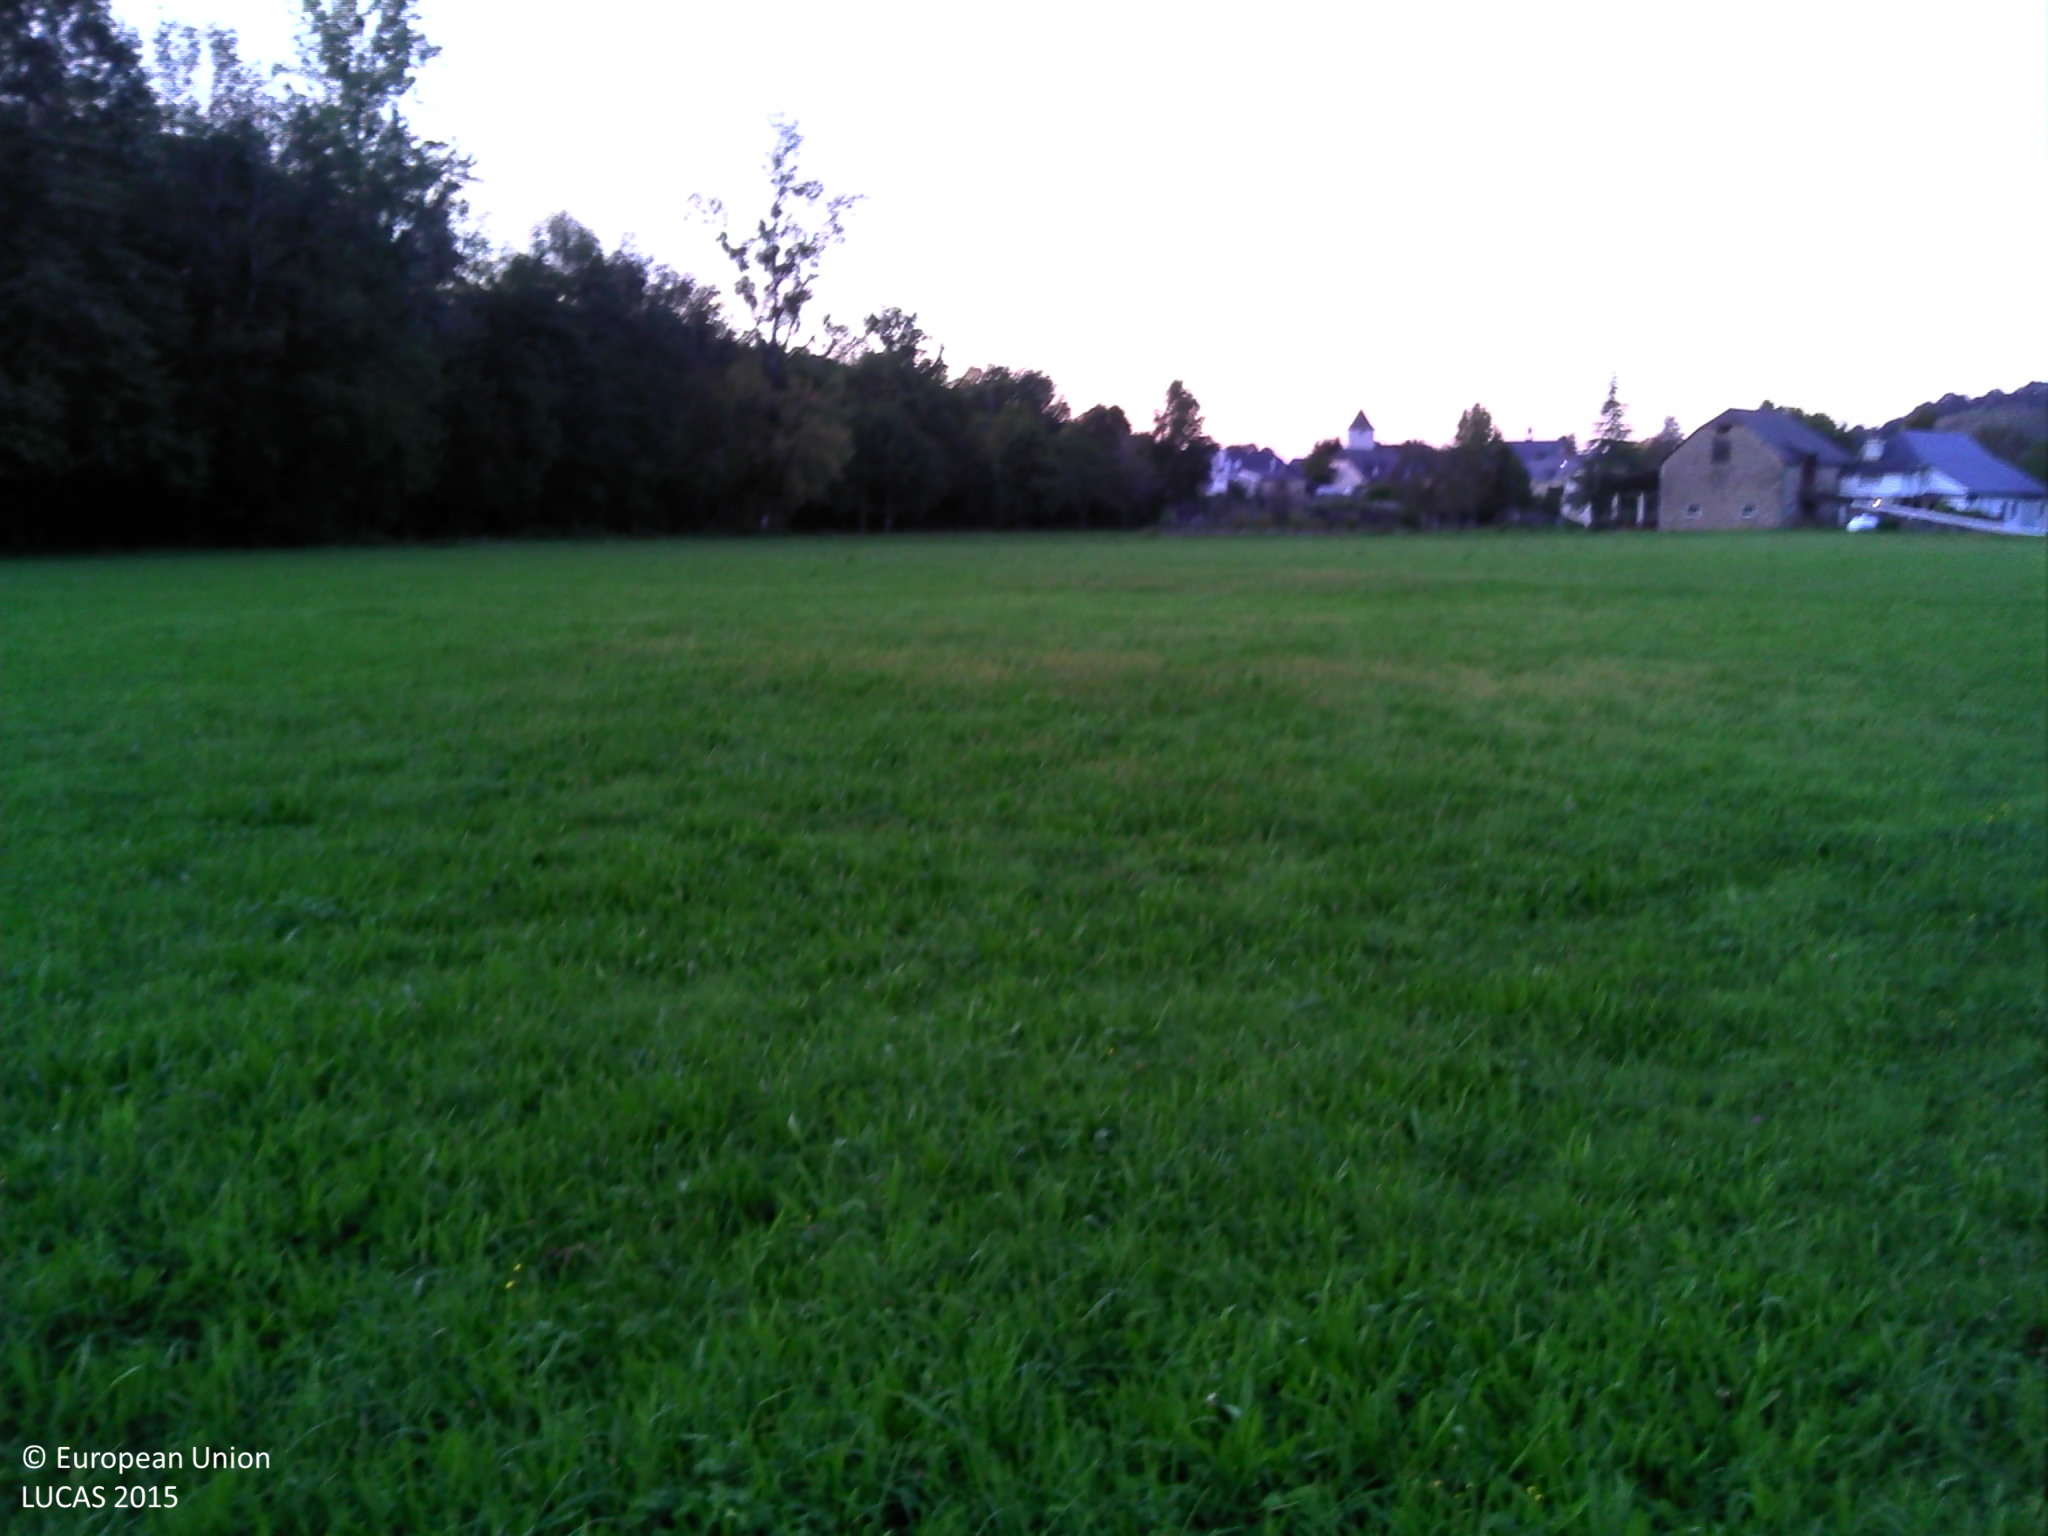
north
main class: Grassland
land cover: Grassland without tree/shrub cover
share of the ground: > 75 %
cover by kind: herbaceous plants 100 %
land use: Agriculture (excluding fallow land and kitchen gardens)
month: September
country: FR
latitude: 43.1418
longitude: -0.6927
